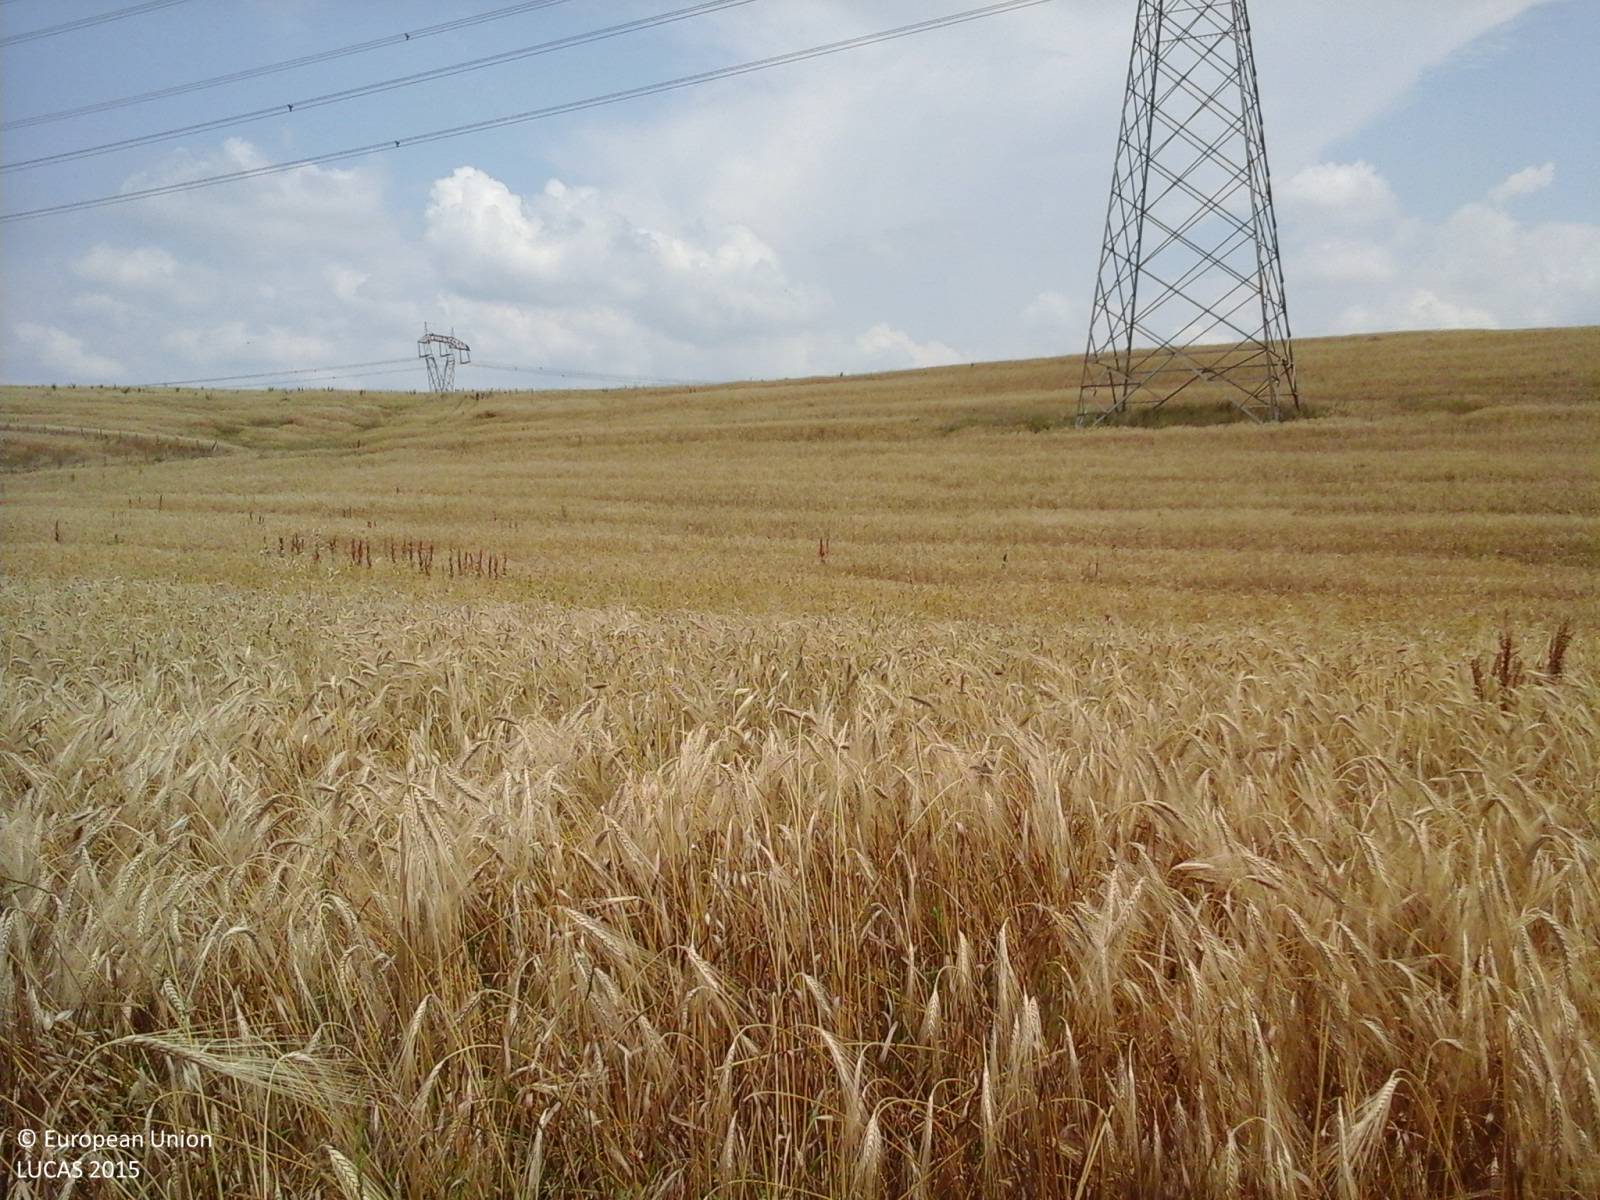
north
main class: Cropland
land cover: Barley
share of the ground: > 75 %
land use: Agriculture (excluding fallow land and kitchen gardens)
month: June
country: IT
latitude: 42.3702
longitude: 11.6094
